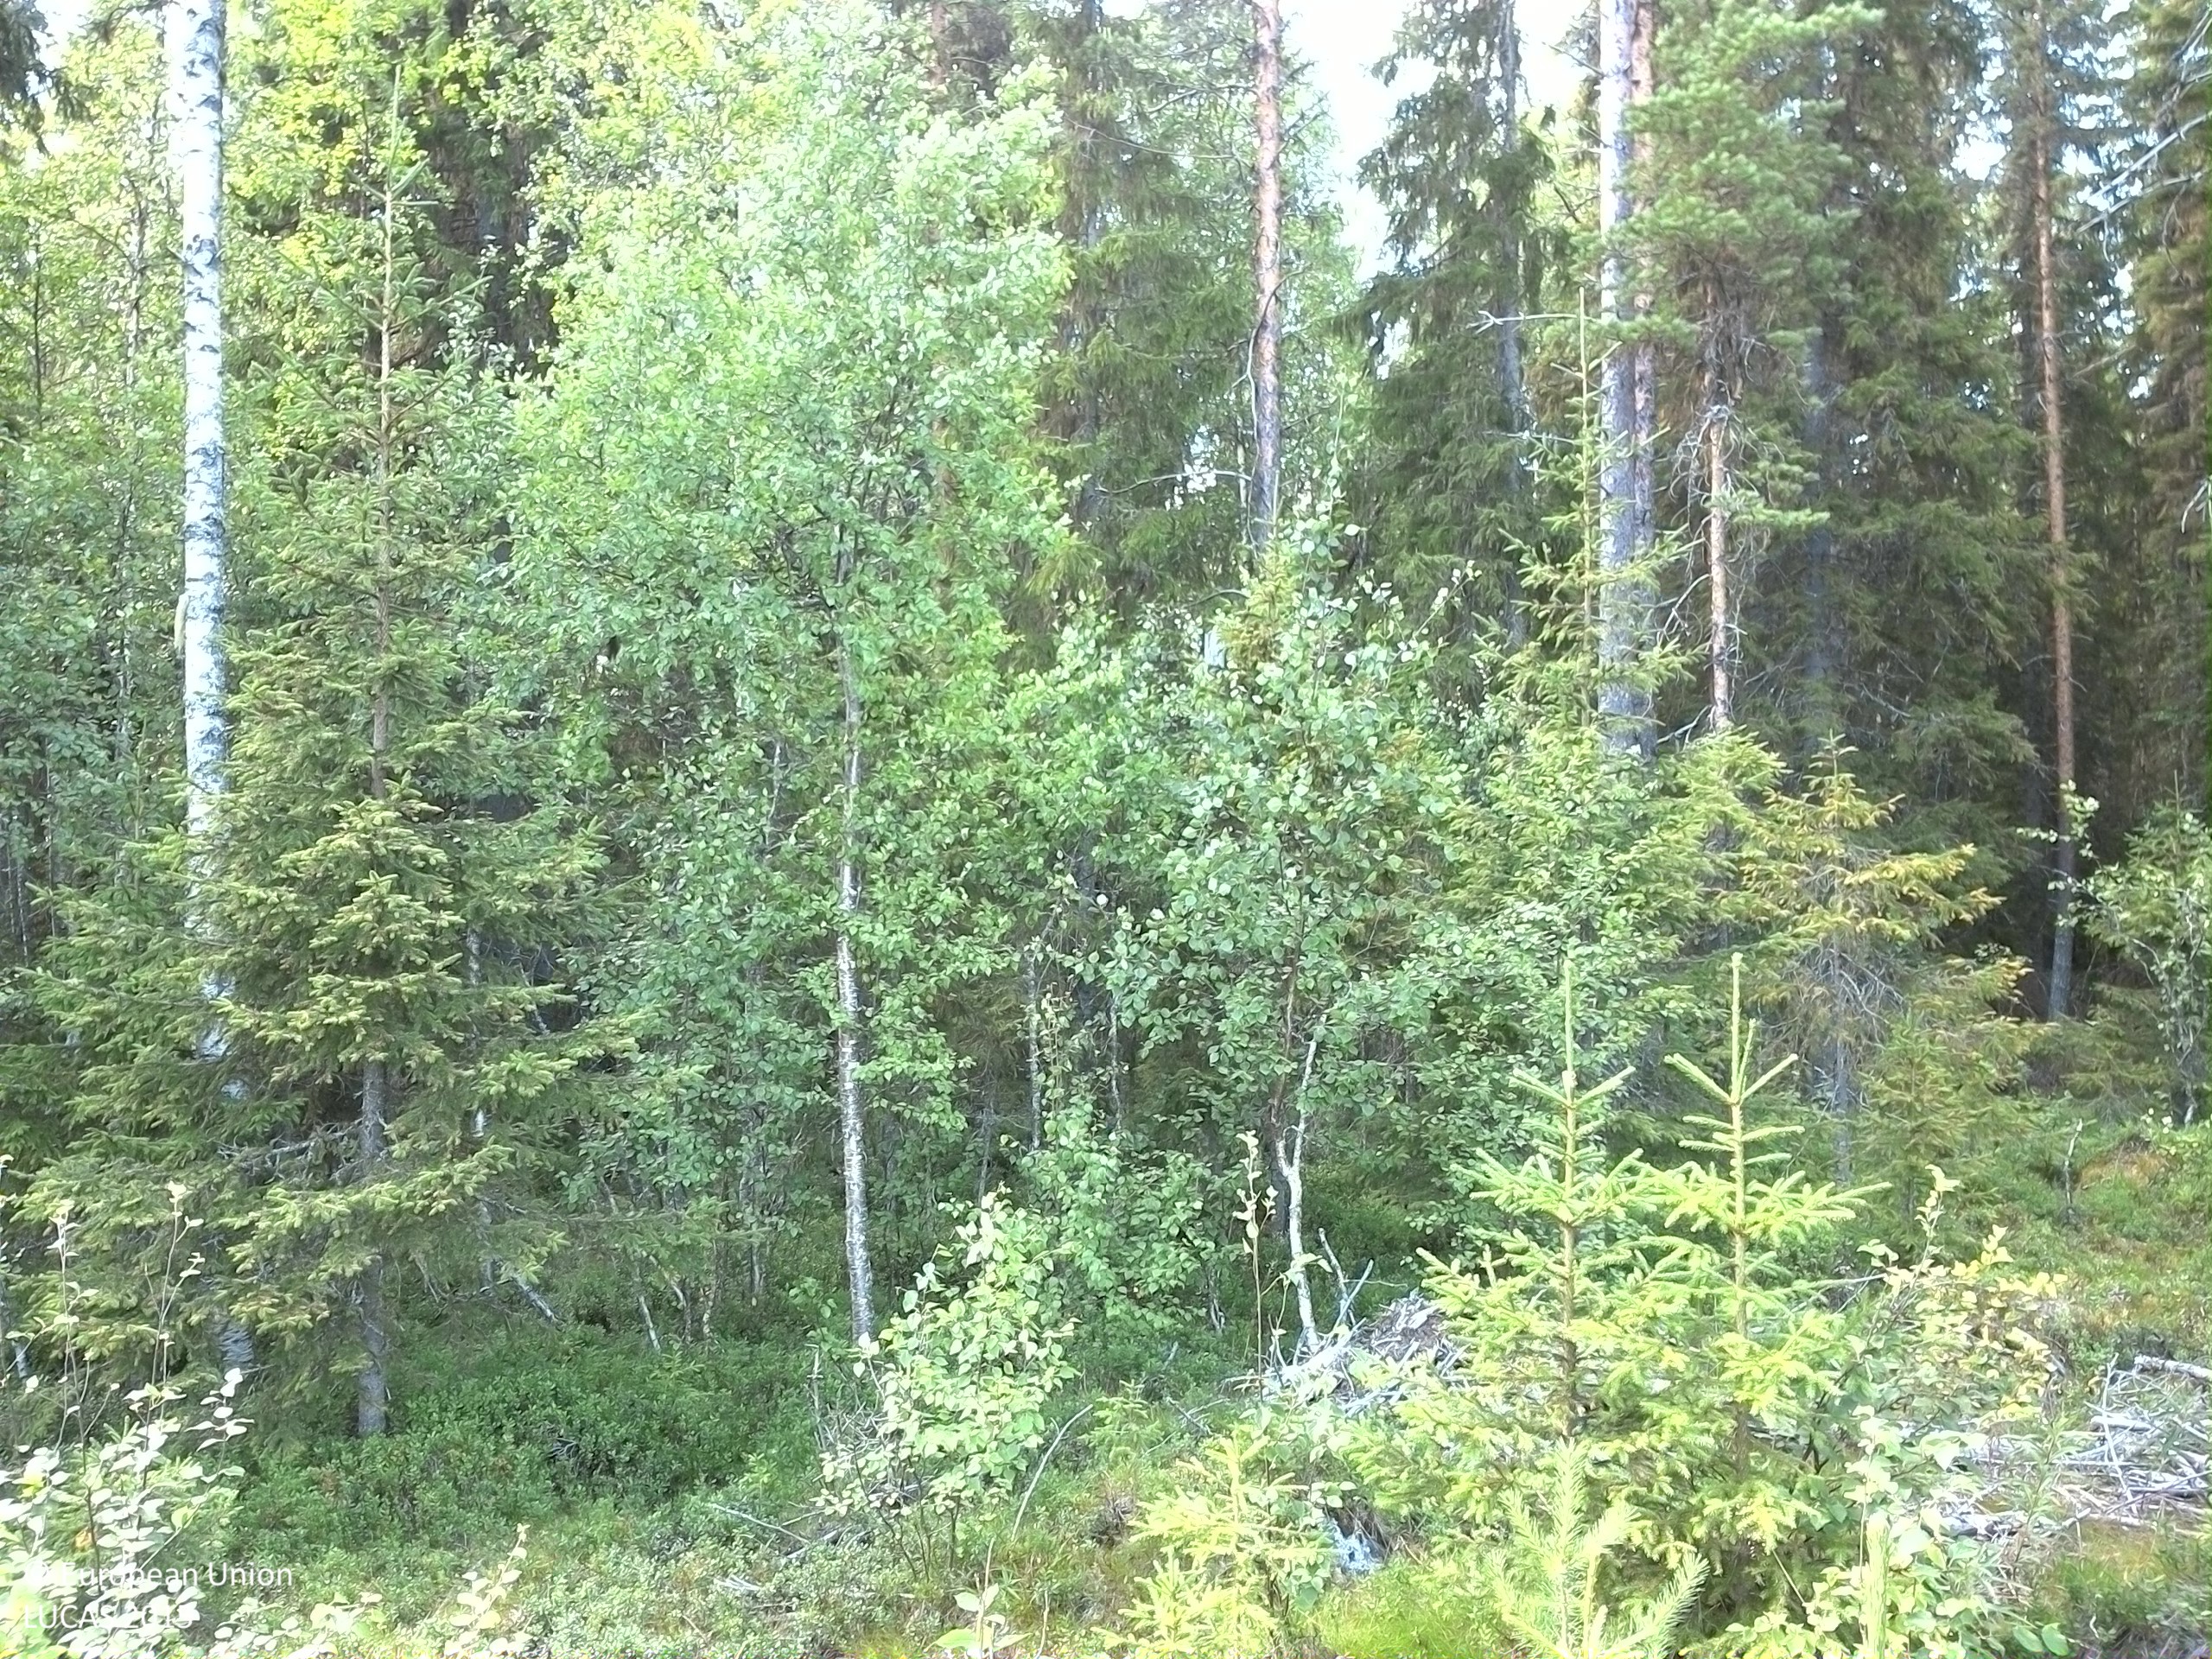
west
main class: Woodland
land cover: Spruce dominated mixed woodland
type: boreal forest
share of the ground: 25 - 50 %
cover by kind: shrubs 30 %, coniferous forest trees 25 %, herbaceous plants 25 %, broadleaved forest trees 15 %, lichens and mosses 5 %
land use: Forestry
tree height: < 5 m
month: August
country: SE
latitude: 64.0879
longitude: 17.6205
